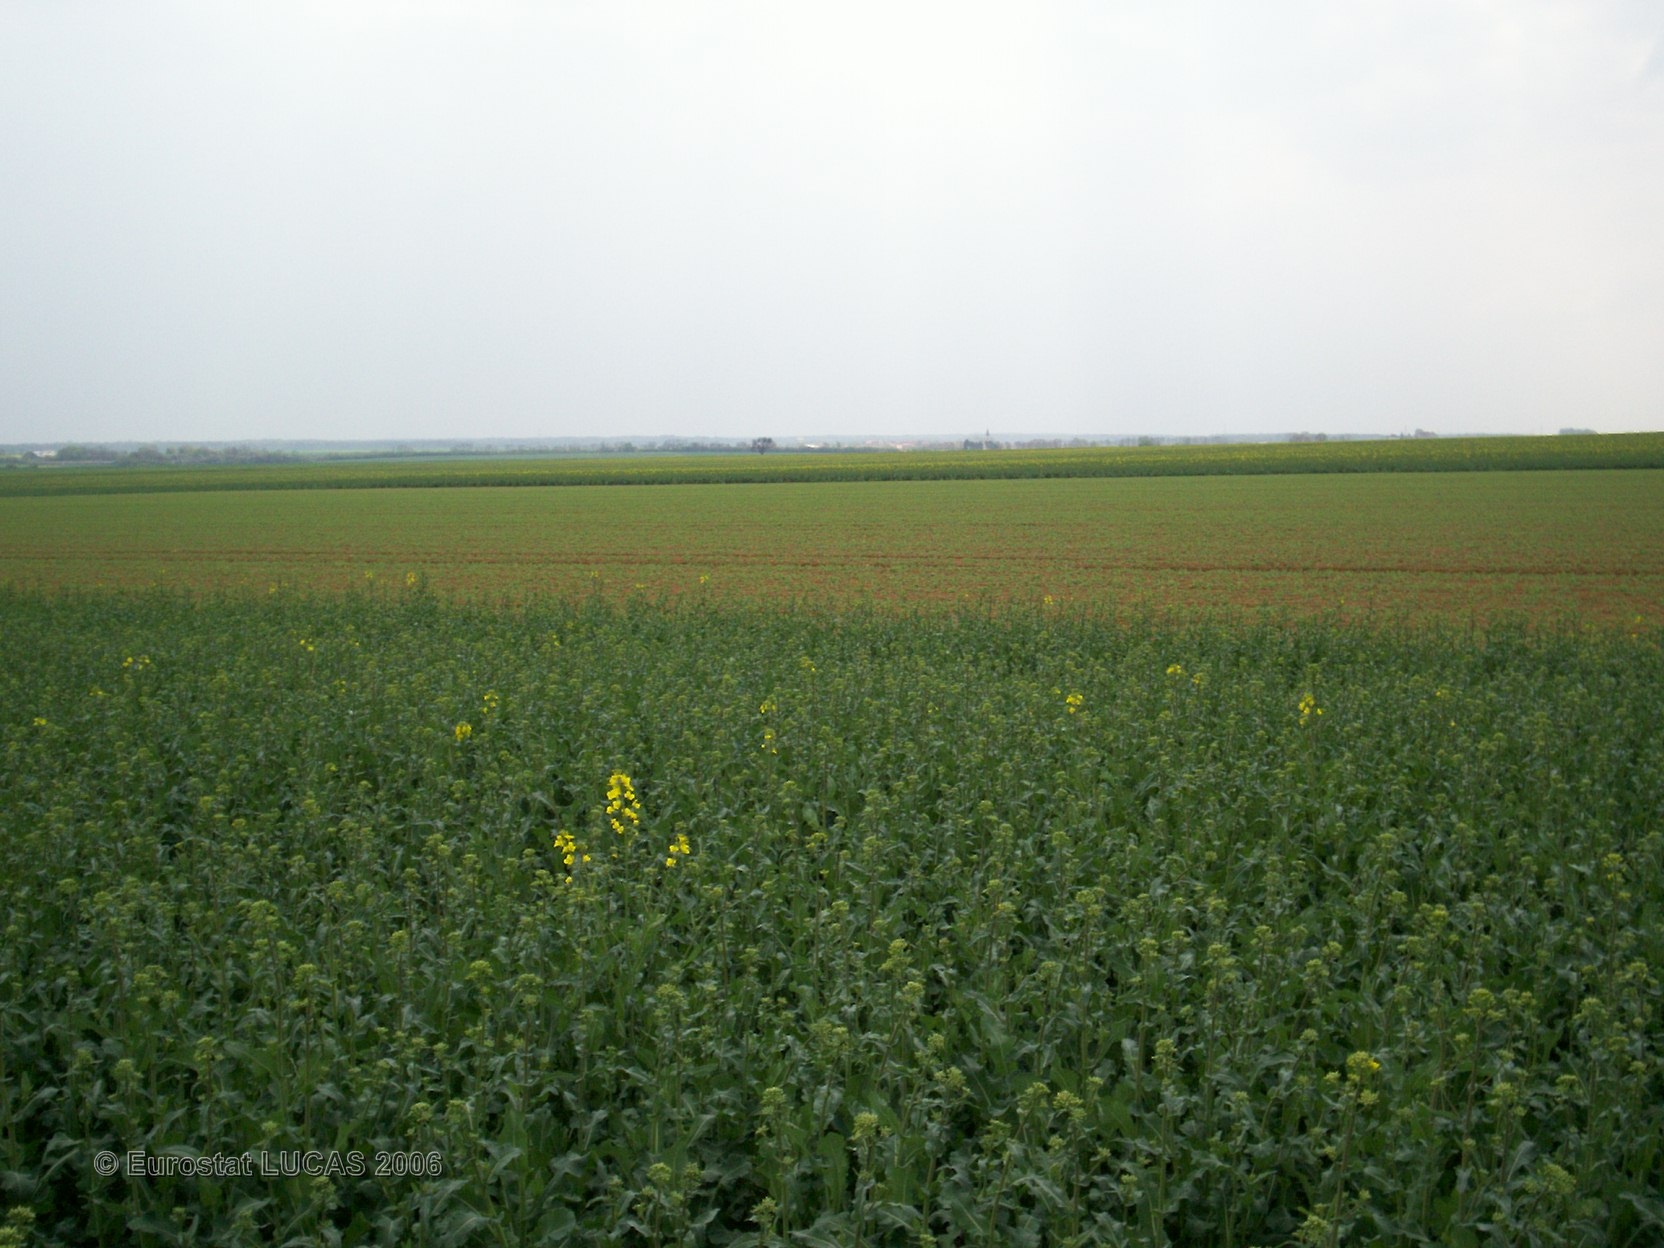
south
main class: Cropland
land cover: Rape and turnip rape
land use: Agriculture (excluding fallow land and kitchen gardens)
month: April
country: FR
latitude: 47.8880
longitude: 4.5017
